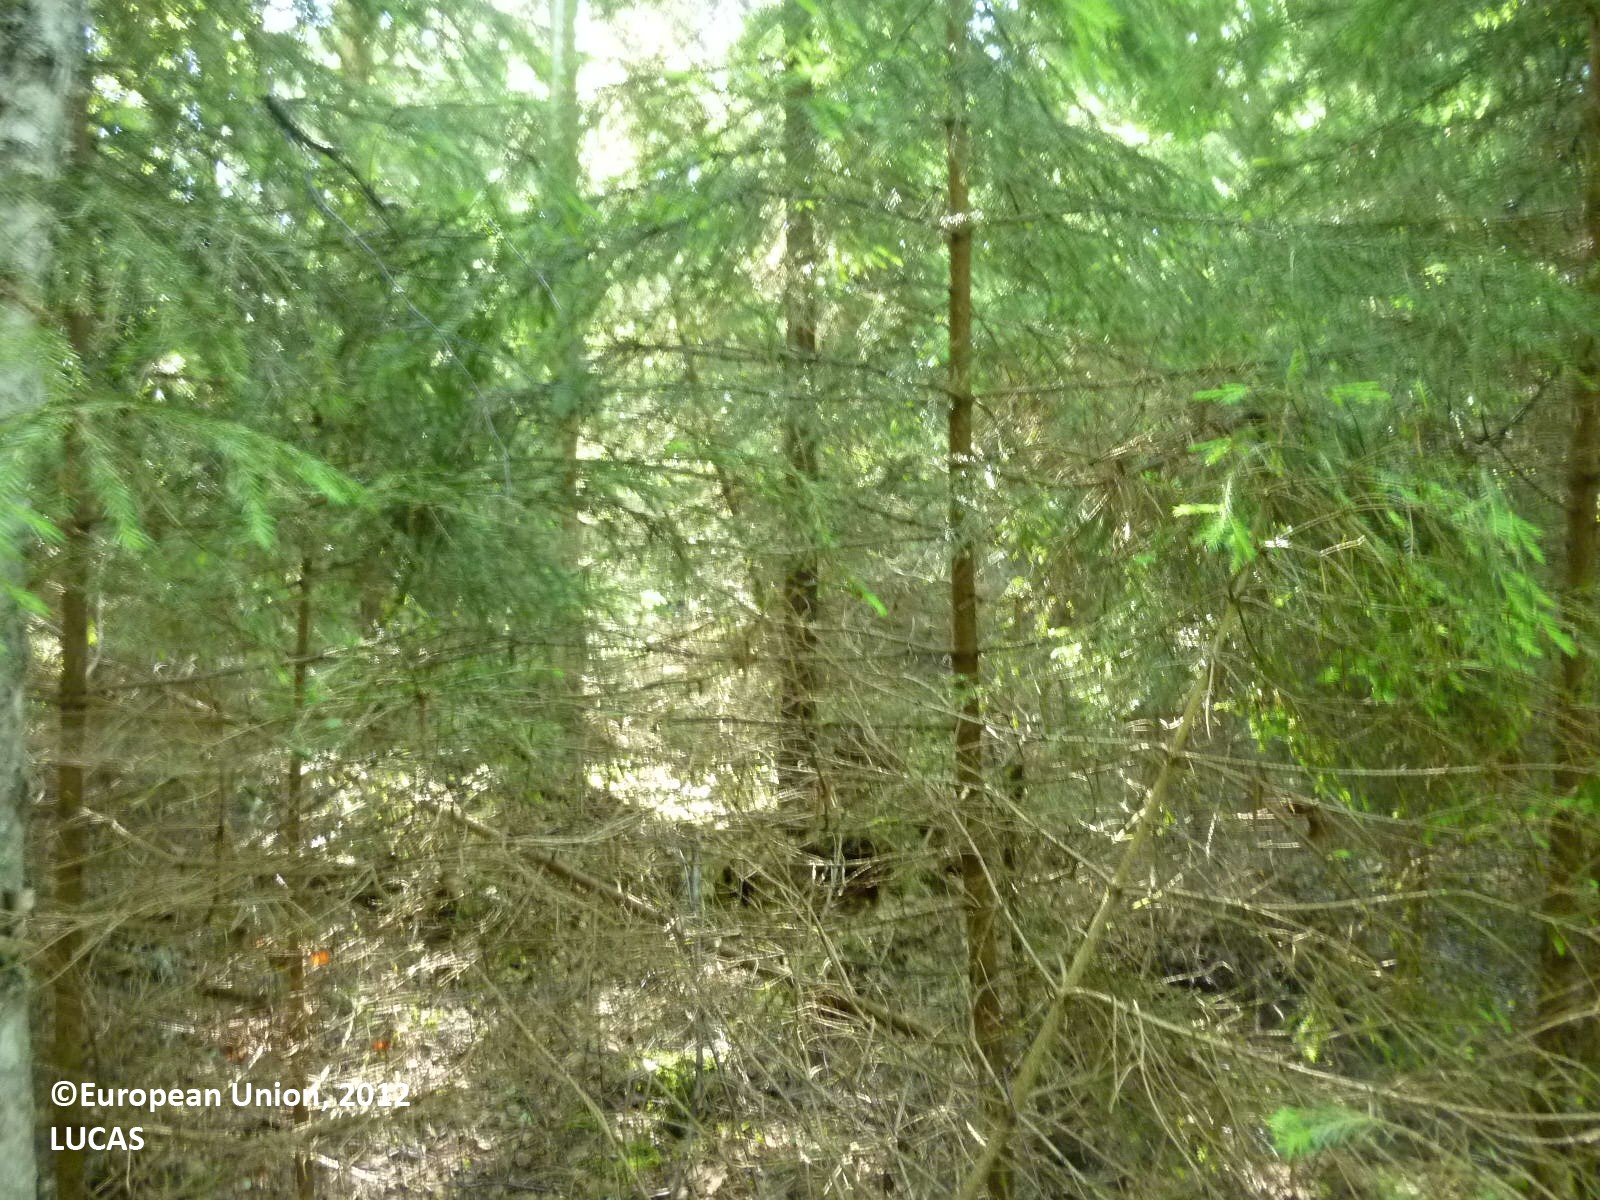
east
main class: Woodland
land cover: Spruce dominated mixed woodland
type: boreal forest
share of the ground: > 75 %
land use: Forestry
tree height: > 5 m
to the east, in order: Pine dominated mixed woodland; Ditches and canals; Pine dominated coniferous woodland; Spruce dominated mixed woodland
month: June
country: FI
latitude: 61.6604
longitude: 22.1622
